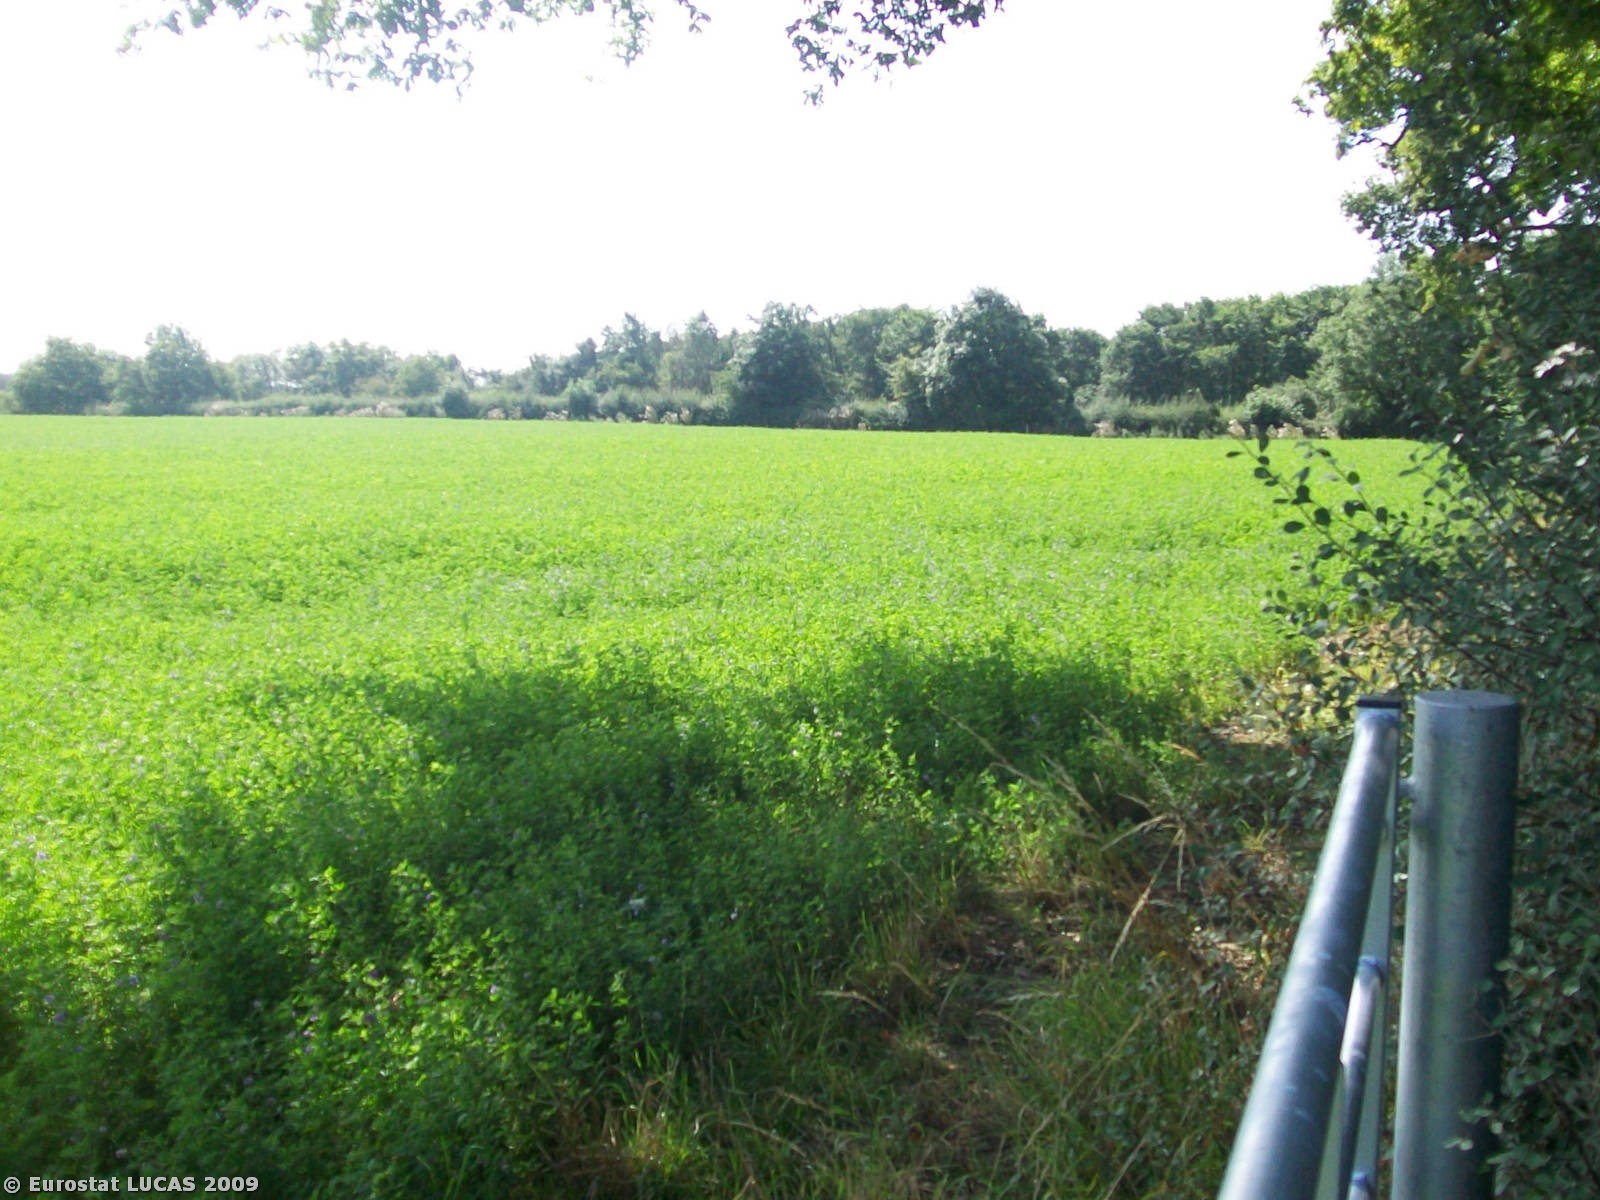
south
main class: Cropland
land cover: Lucerne
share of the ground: > 75 %
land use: Agriculture (excluding fallow land and kitchen gardens)
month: August
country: GB
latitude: 51.8880
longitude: 0.0734
